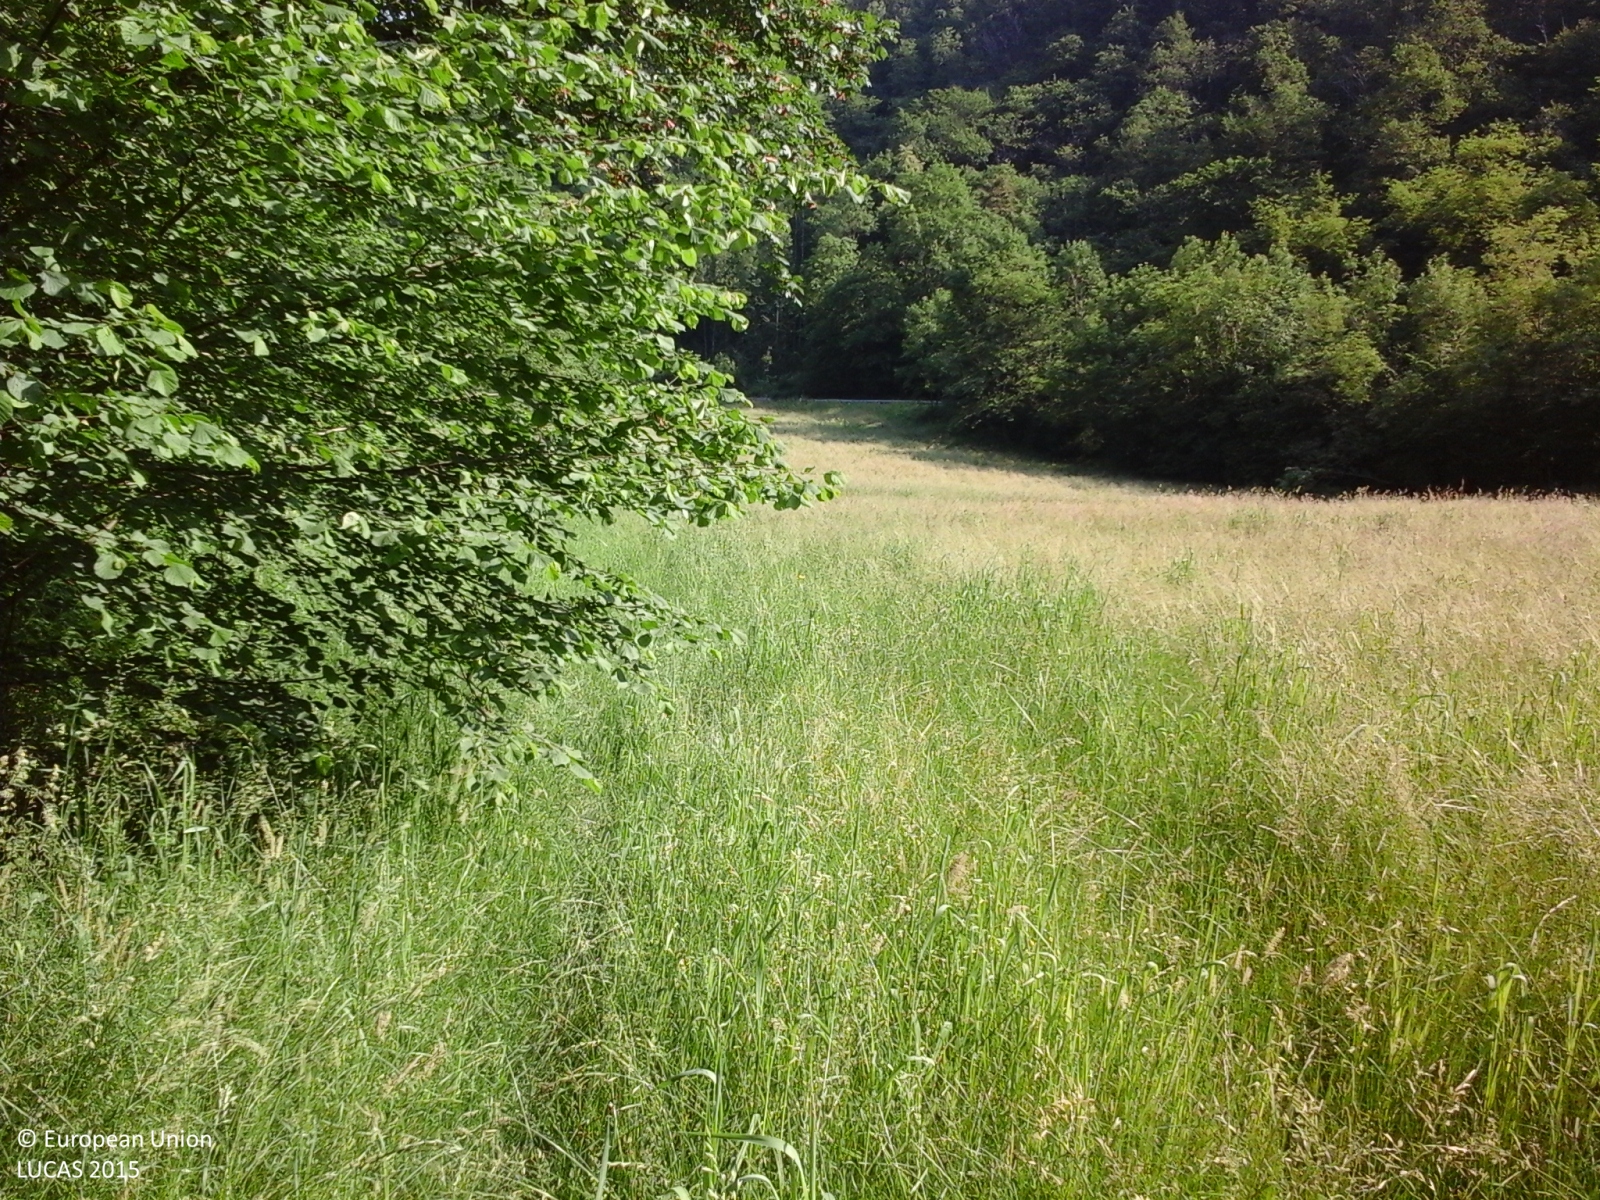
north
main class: Grassland
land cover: Grassland without tree/shrub cover
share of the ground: > 75 %
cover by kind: herbaceous plants 100 %
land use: Agriculture (excluding fallow land and kitchen gardens)
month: June
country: IT
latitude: 45.8162
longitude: 8.3680
